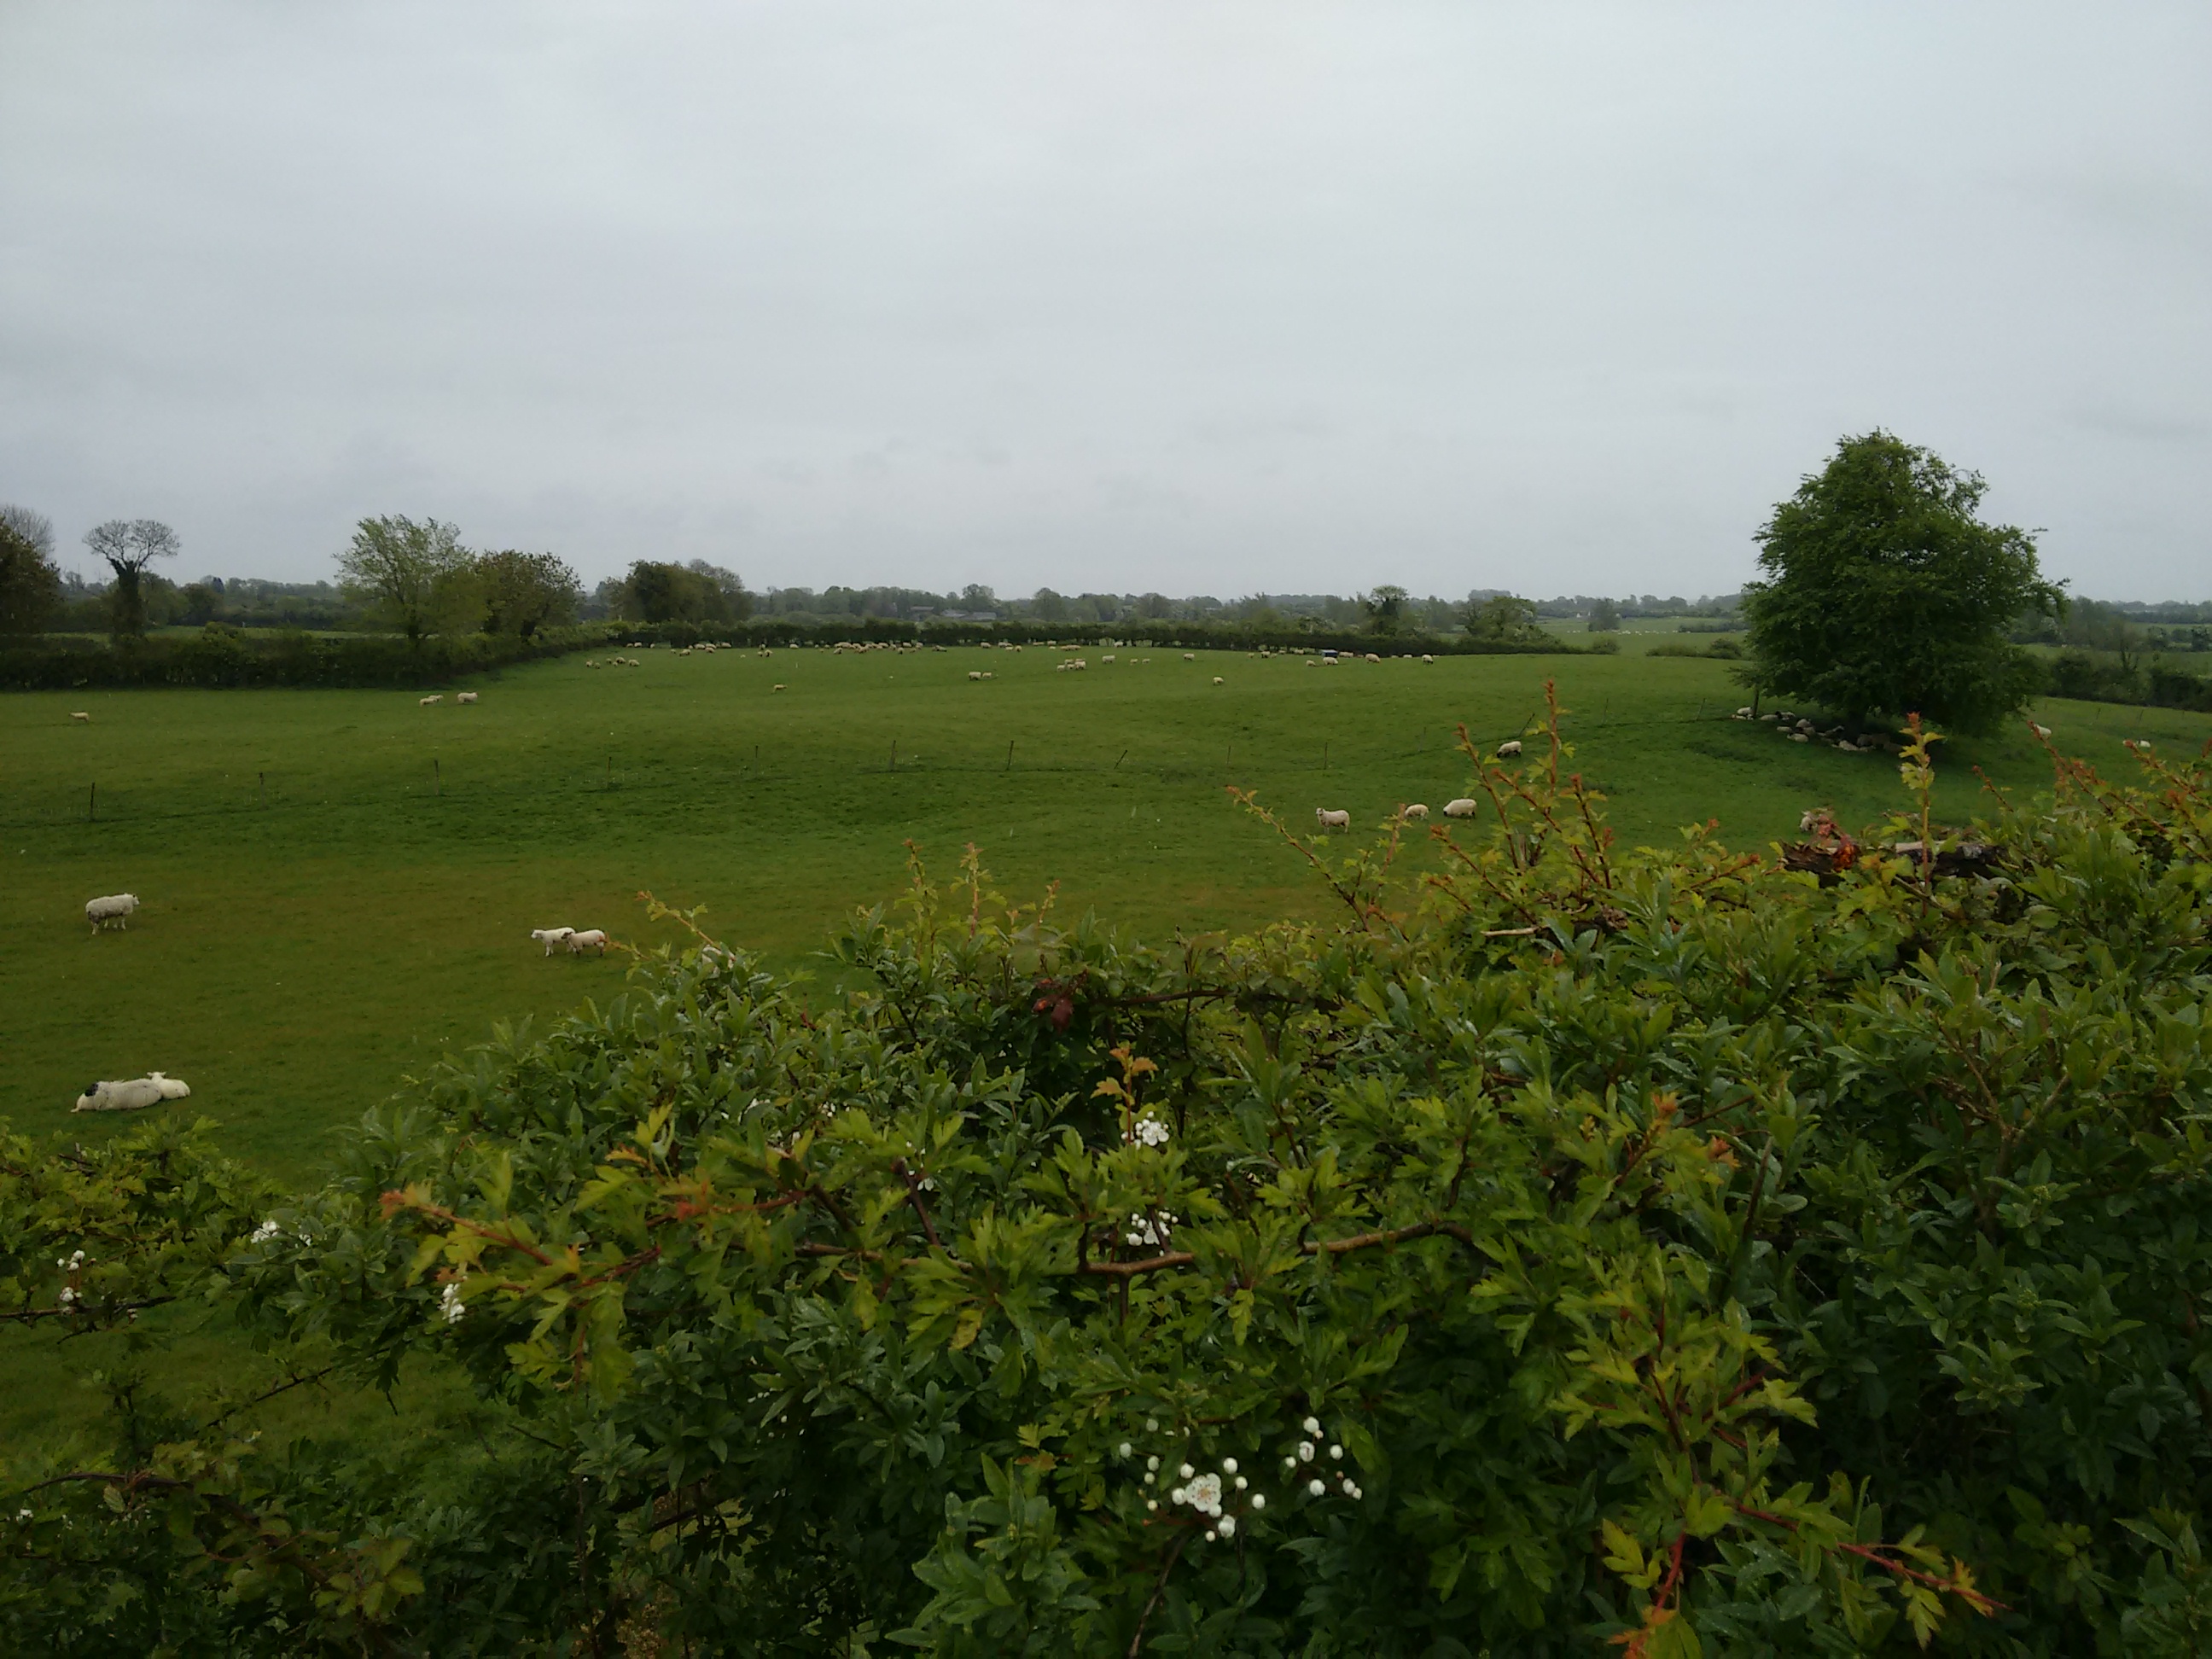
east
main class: Grassland
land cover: Grassland without tree/shrub cover
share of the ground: > 75 %
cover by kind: herbaceous plants 95 %, unconsolidated bare surface 5 %
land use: Agriculture (excluding fallow land and kitchen gardens)
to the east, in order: Grassland without tree/shrub cover; Fences; Grassland without tree/shrub cover; Managed hedges; Grassland without tree/shrub cover
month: May
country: IE
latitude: 53.4616
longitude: -6.9649
